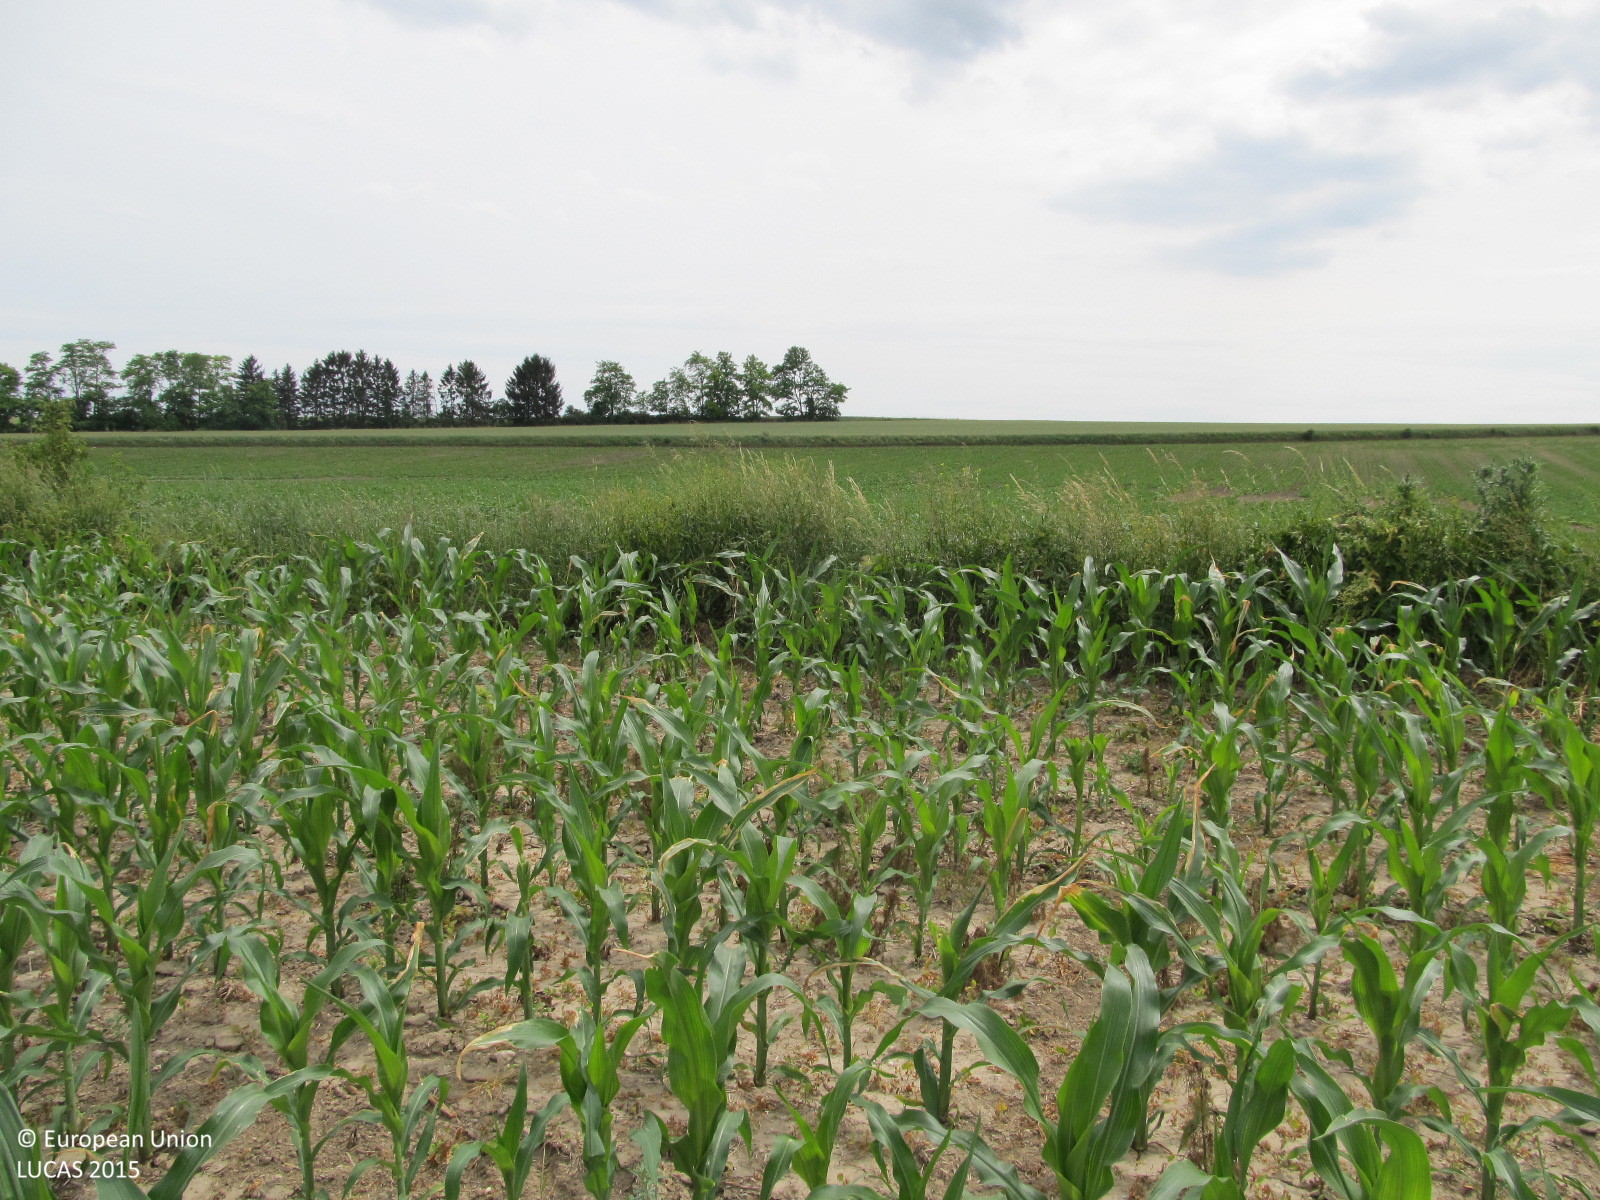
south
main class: Cropland
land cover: Maize
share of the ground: 25 - 50 %
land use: Agriculture (excluding fallow land and kitchen gardens)
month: June
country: AT
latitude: 48.4646
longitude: 15.8598
